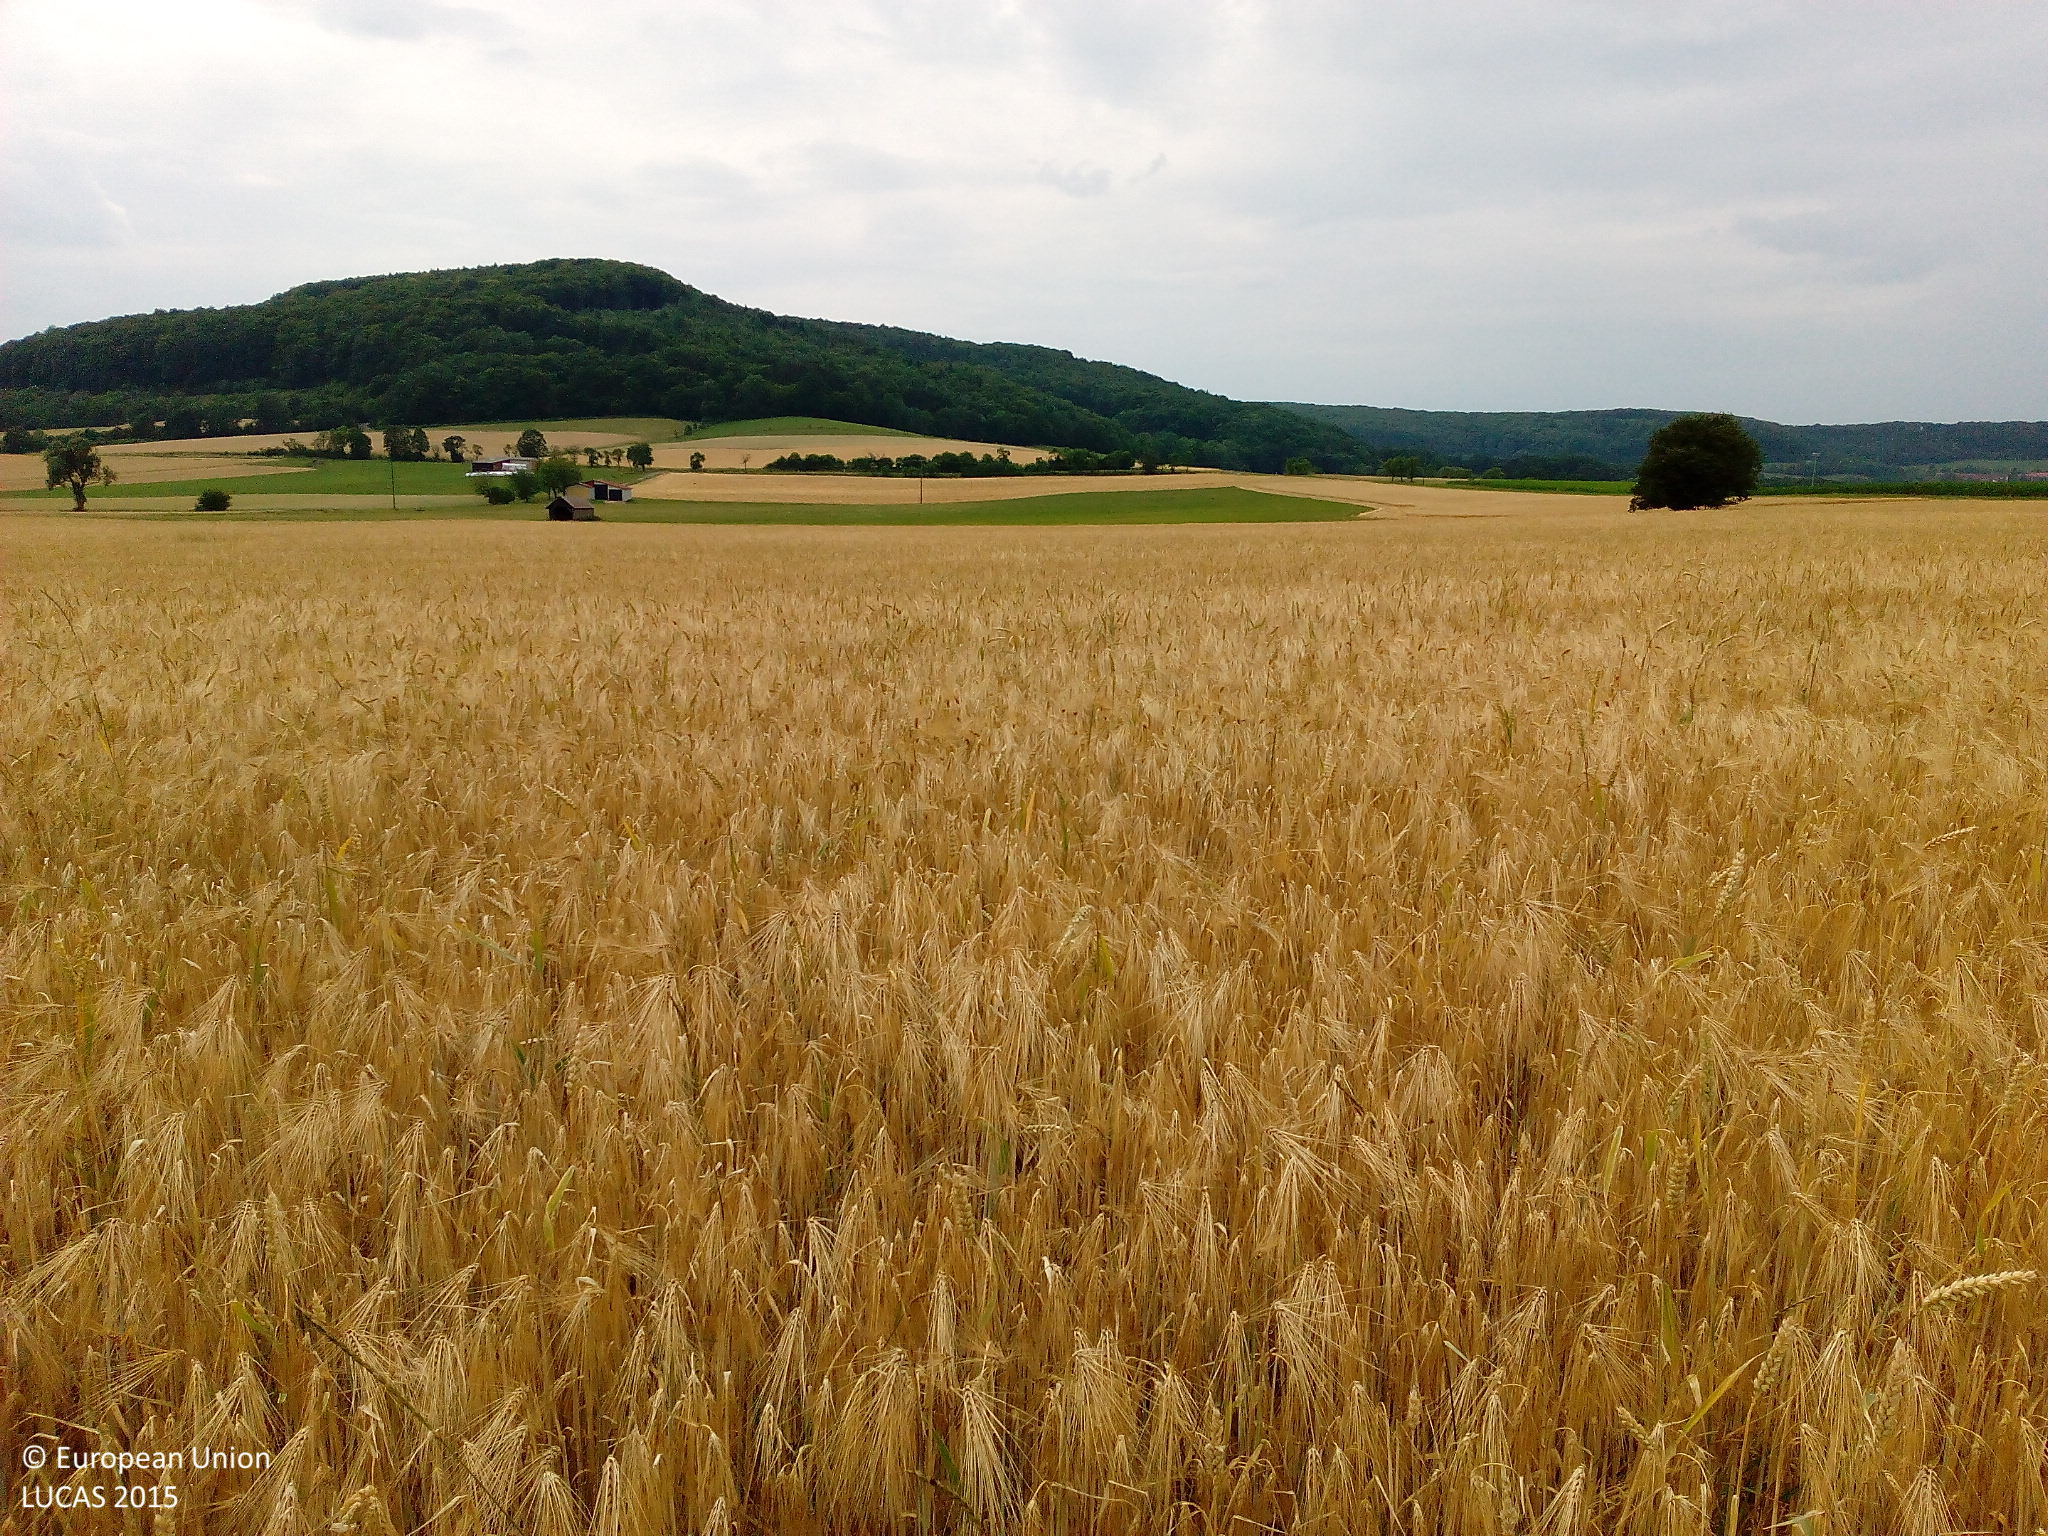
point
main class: Cropland
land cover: Barley
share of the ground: > 75 %
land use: Agriculture (excluding fallow land and kitchen gardens)
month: July
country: DE
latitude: 50.7955
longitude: 9.9291
